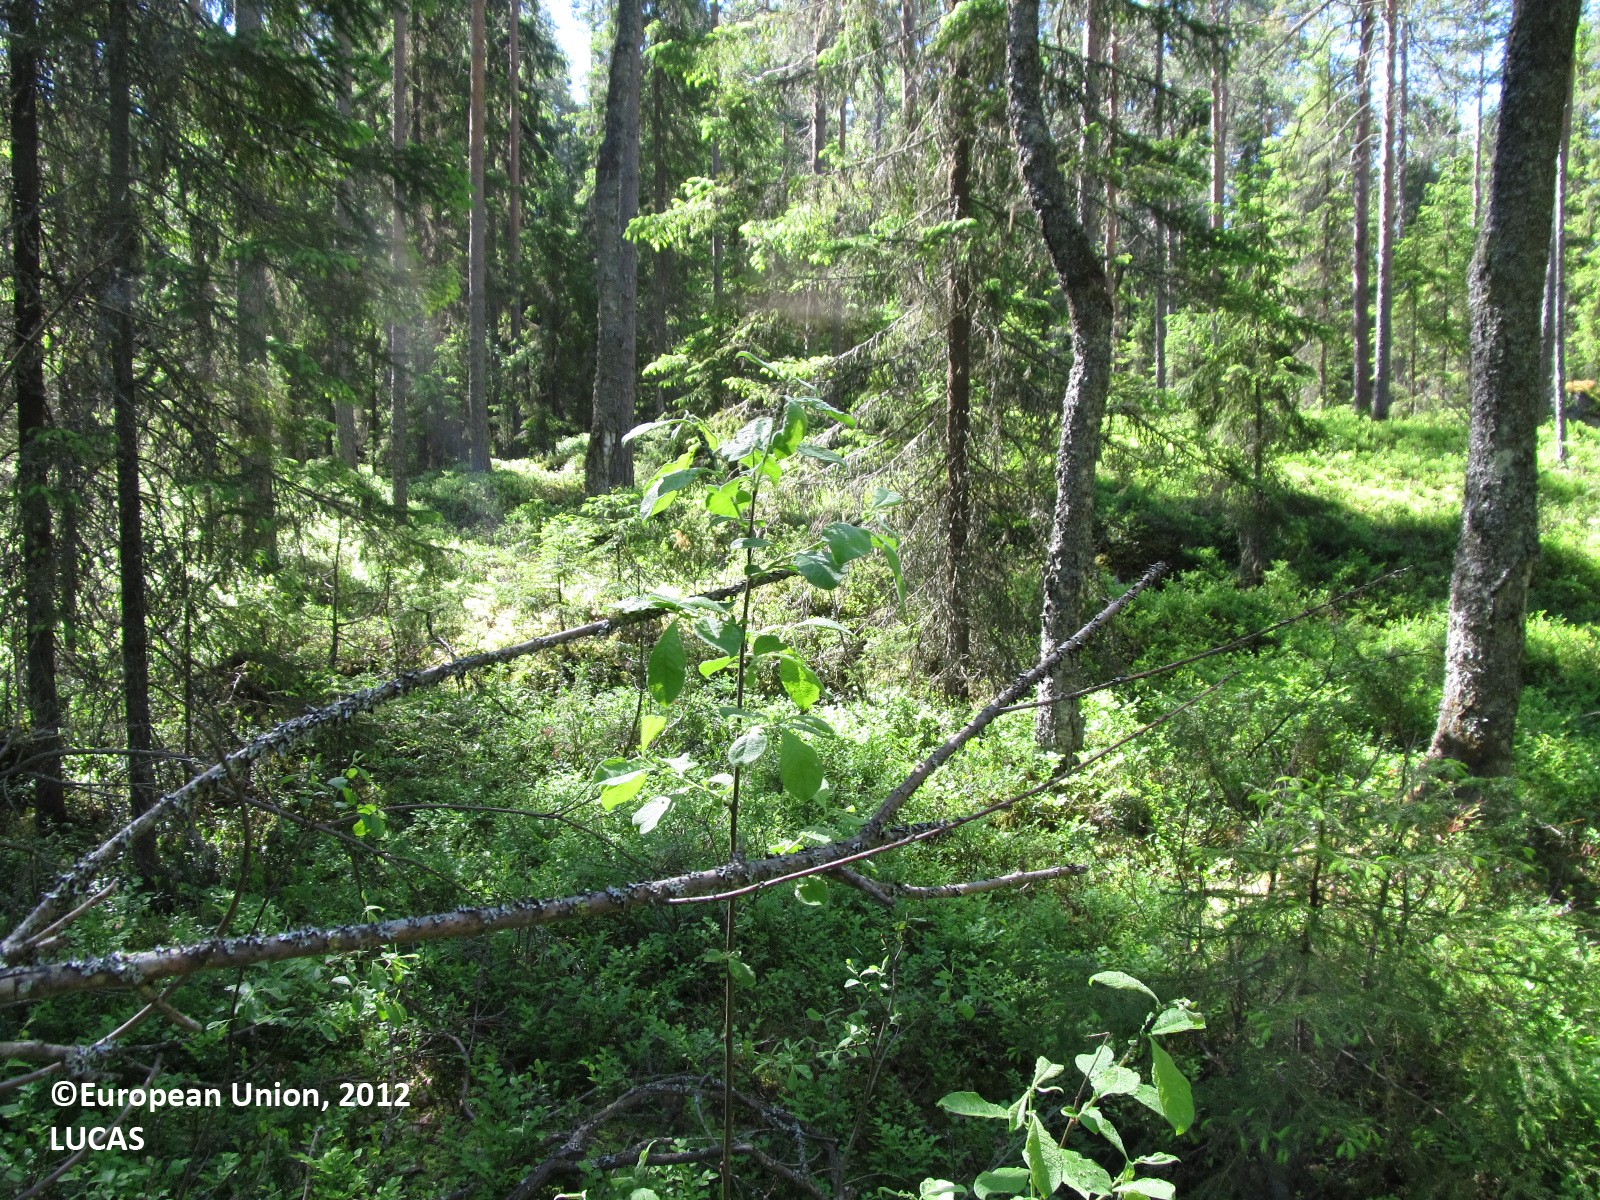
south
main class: Woodland
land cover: Other coniferous woodland
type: boreal forest
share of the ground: 25 - 50 %
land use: Forestry
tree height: > 5 m
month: June
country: FI
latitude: 62.9925
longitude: 27.7571
